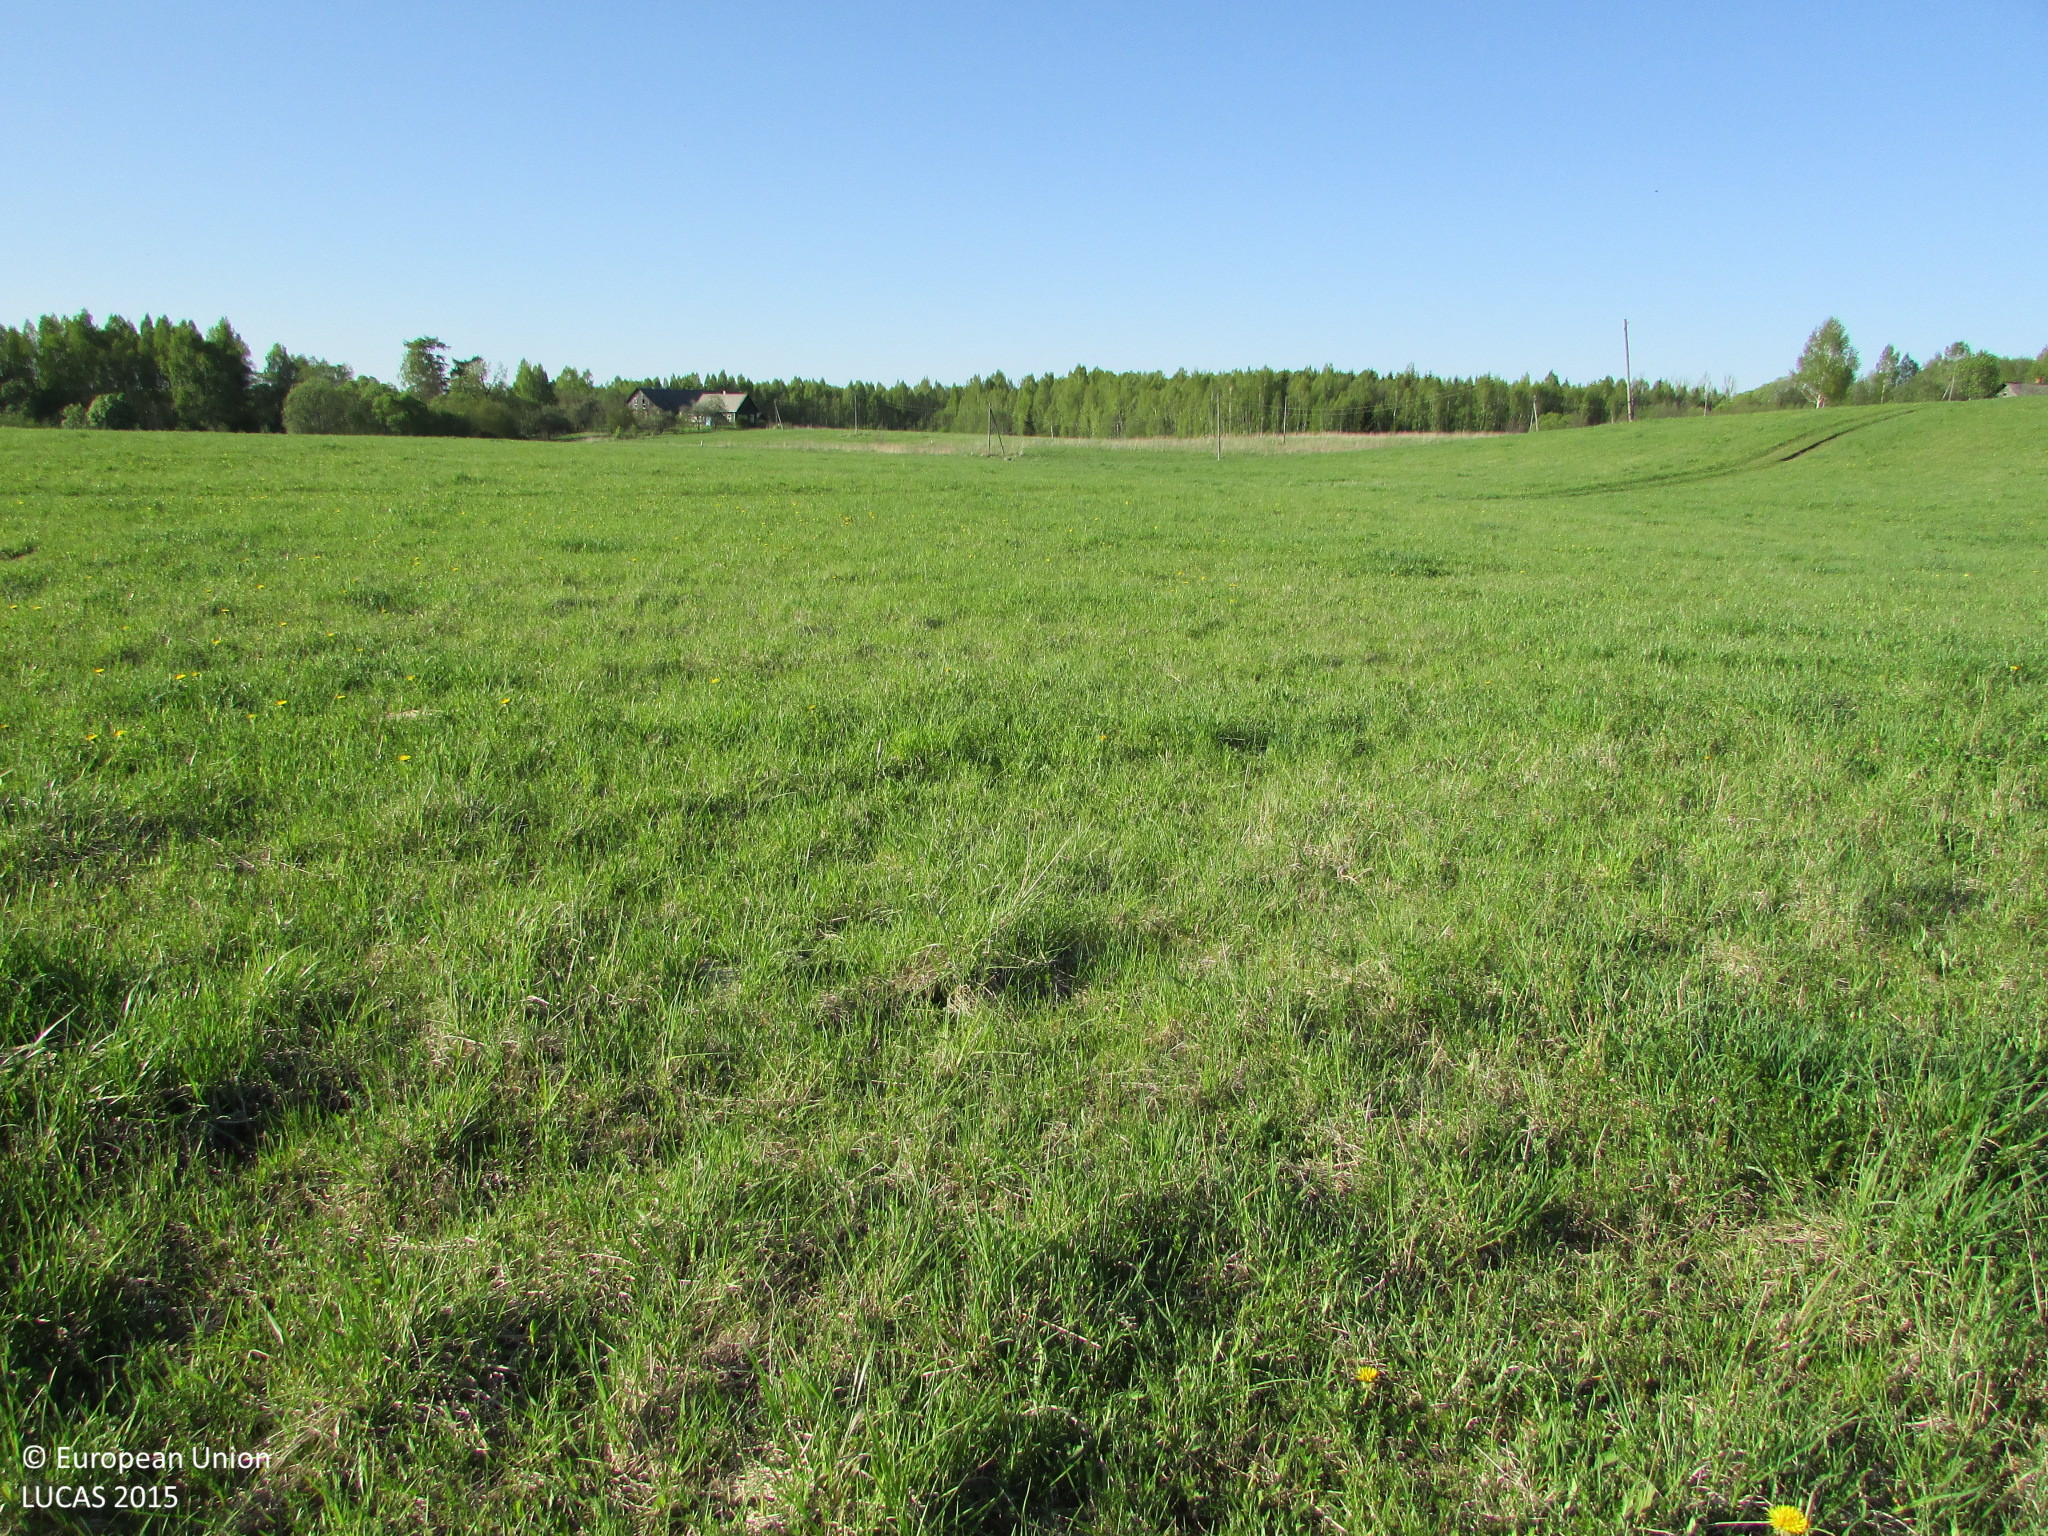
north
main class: Grassland
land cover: Grassland without tree/shrub cover
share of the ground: > 75 %
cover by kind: herbaceous plants 100 %
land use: Agriculture (excluding fallow land and kitchen gardens)
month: May
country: LV
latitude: 55.9019
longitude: 27.5701
